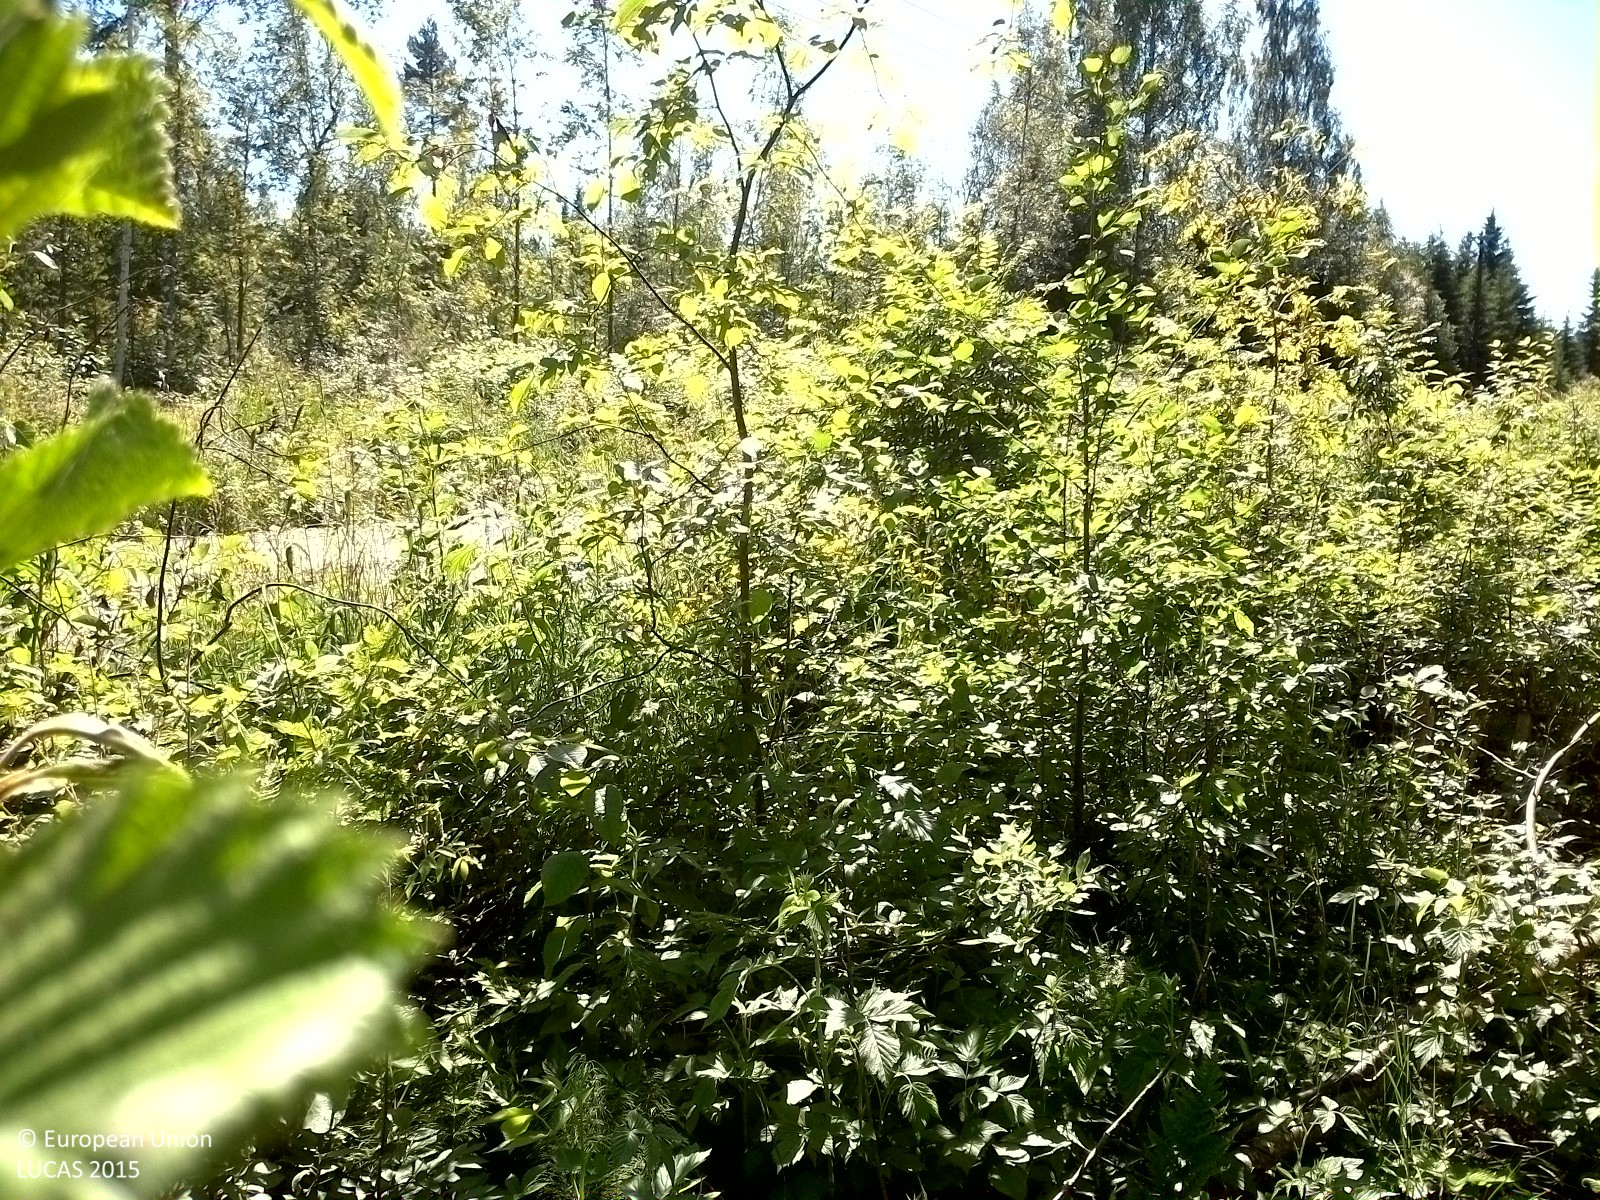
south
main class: Woodland
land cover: Broadleaved woodland
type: boreal forest
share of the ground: 50 - 75 %
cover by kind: broadleaved forest trees 70 %, herbaceous plants 30 %
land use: Semi-natural and natural areas not in use
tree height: > 5 m
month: July
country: SE
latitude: 62.2732
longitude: 16.8973
